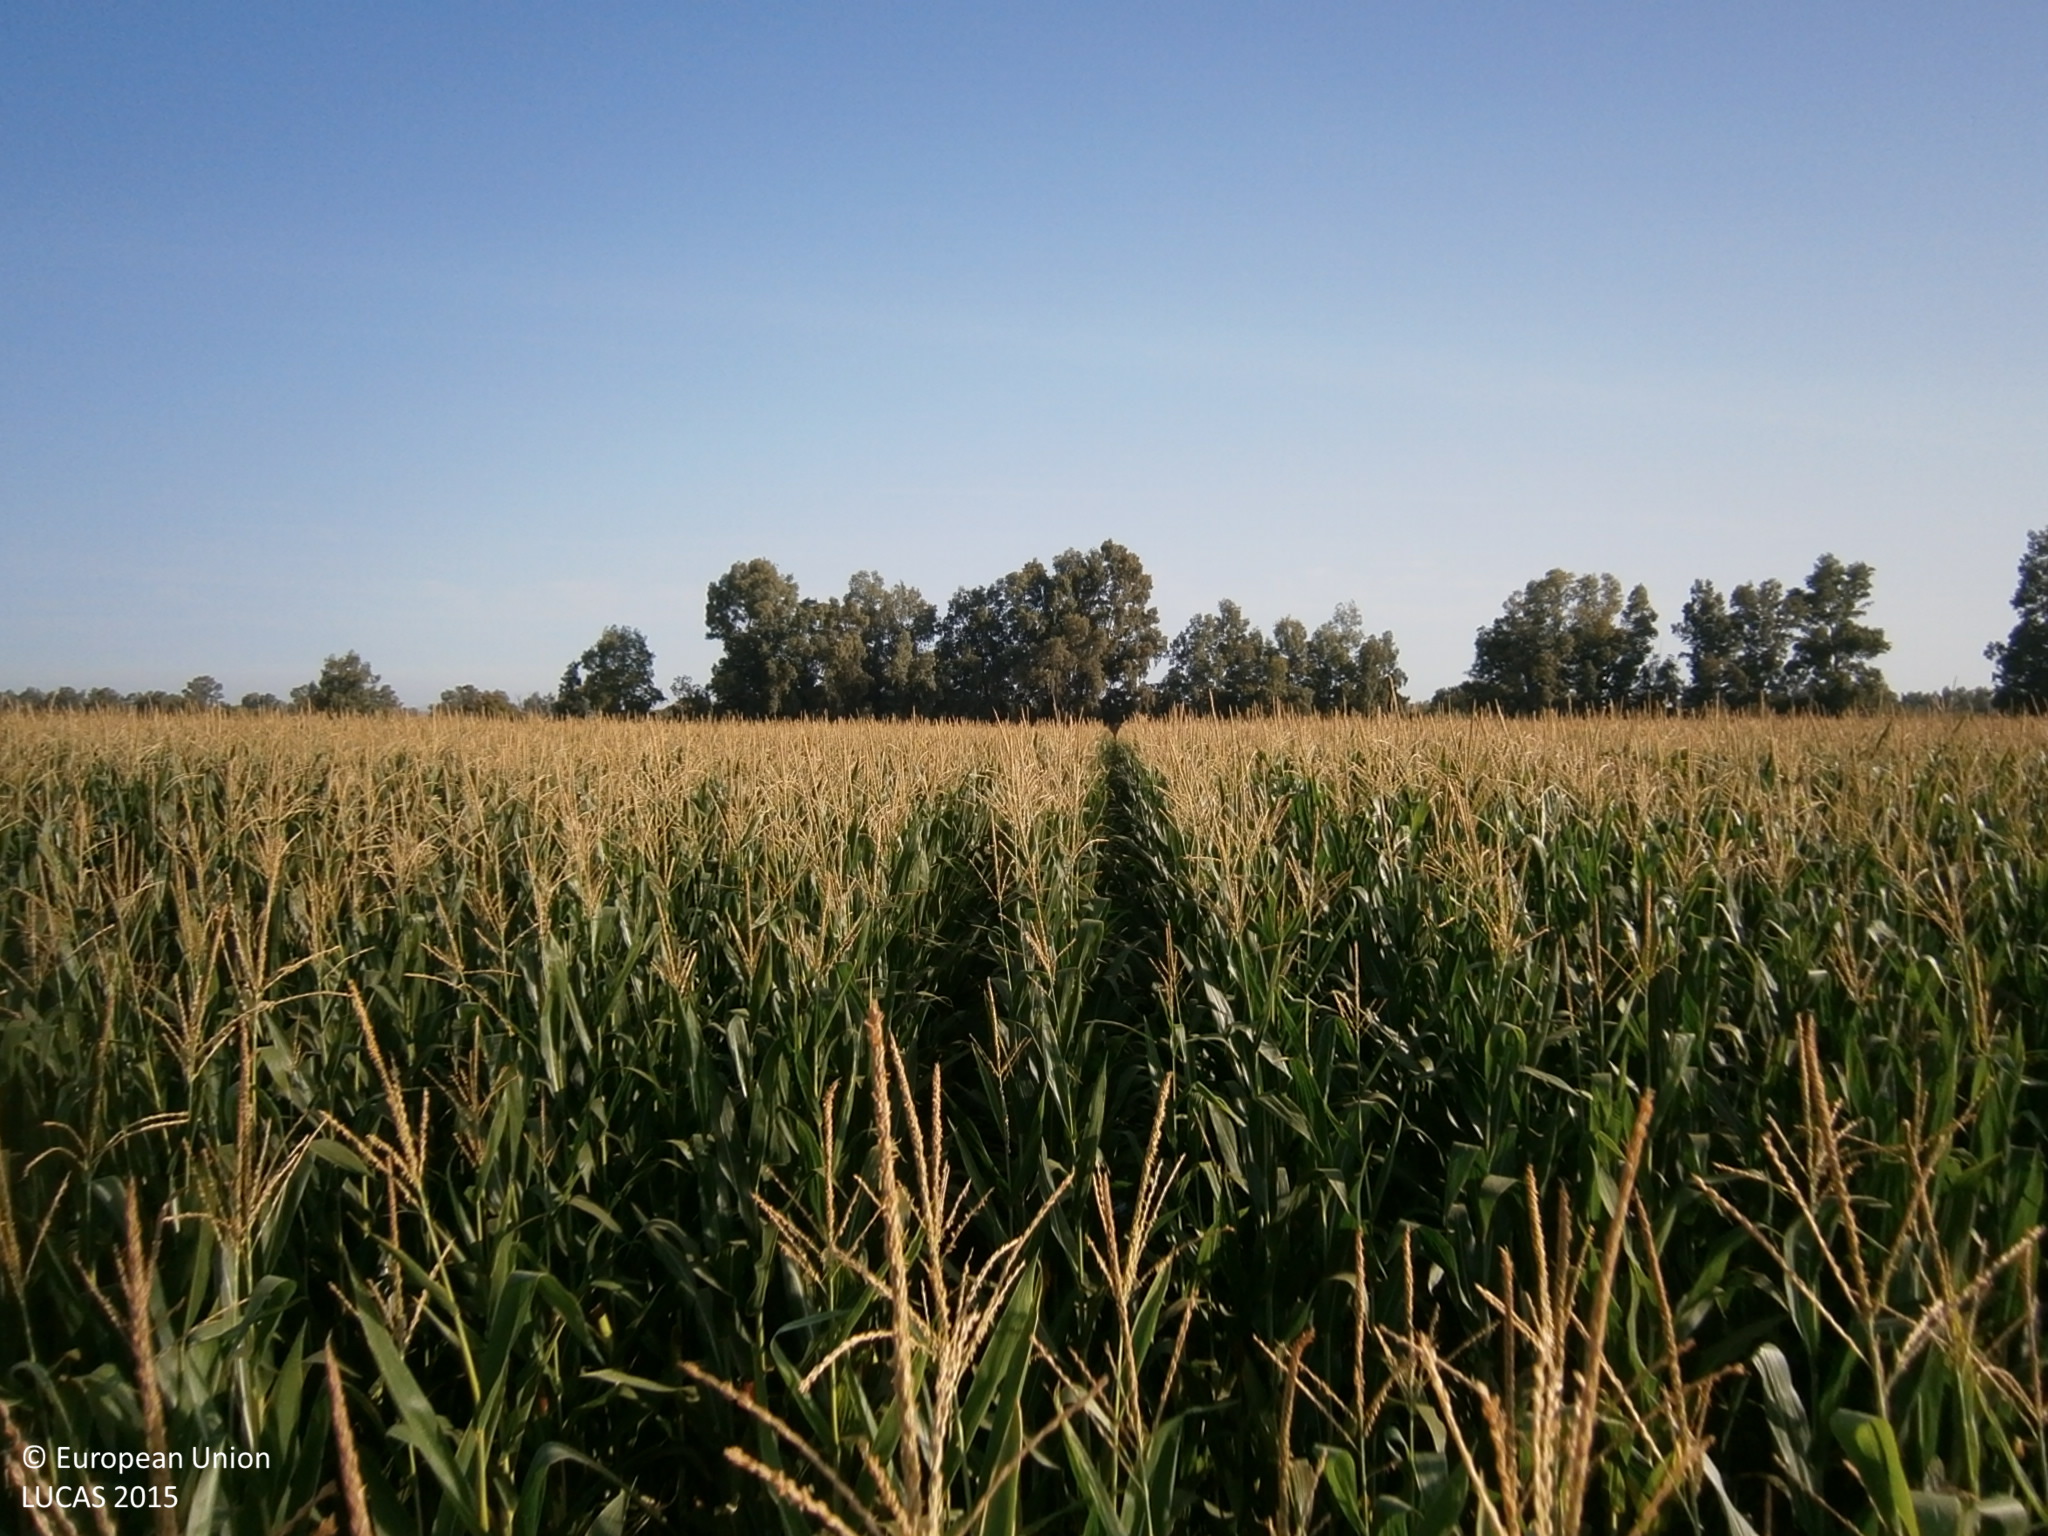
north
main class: Cropland
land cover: Maize
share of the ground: > 75 %
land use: Agriculture (excluding fallow land and kitchen gardens)
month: July
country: ES
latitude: 38.9013
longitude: -6.8918
